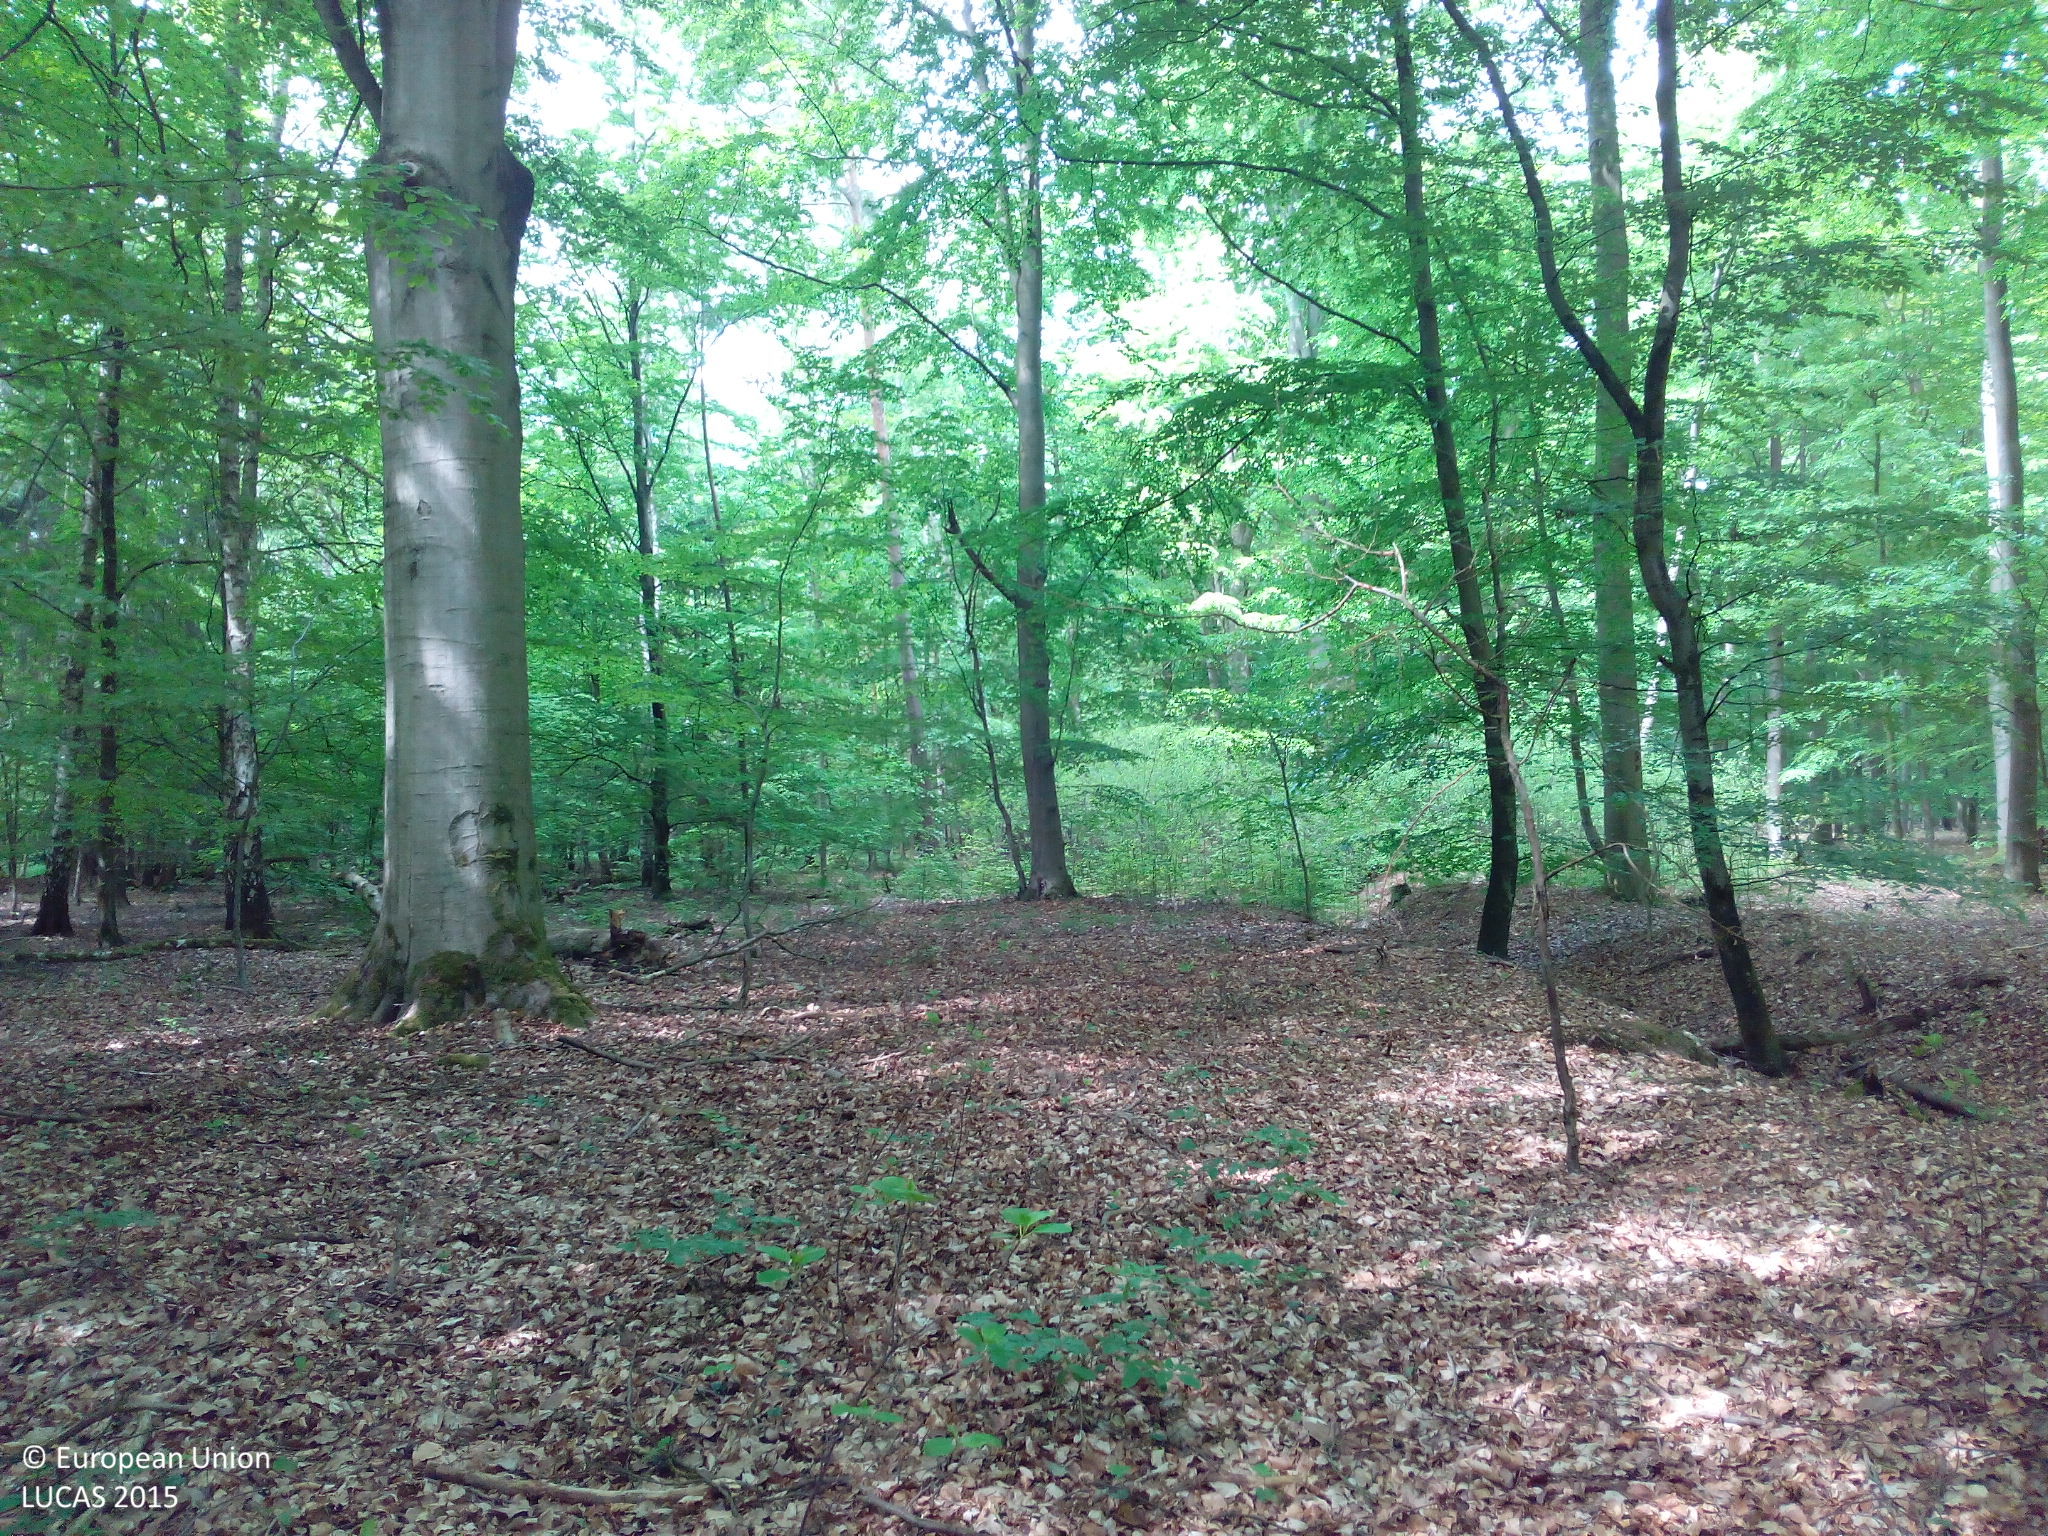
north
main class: Woodland
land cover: Broadleaved woodland
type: beech forest
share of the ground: 25 - 50 %
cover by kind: broadleaved forest trees 80 %, unconsolidated bare surface 20 %
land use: Forestry
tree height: > 5 m
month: May
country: DE
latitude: 53.4987
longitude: 11.6425
